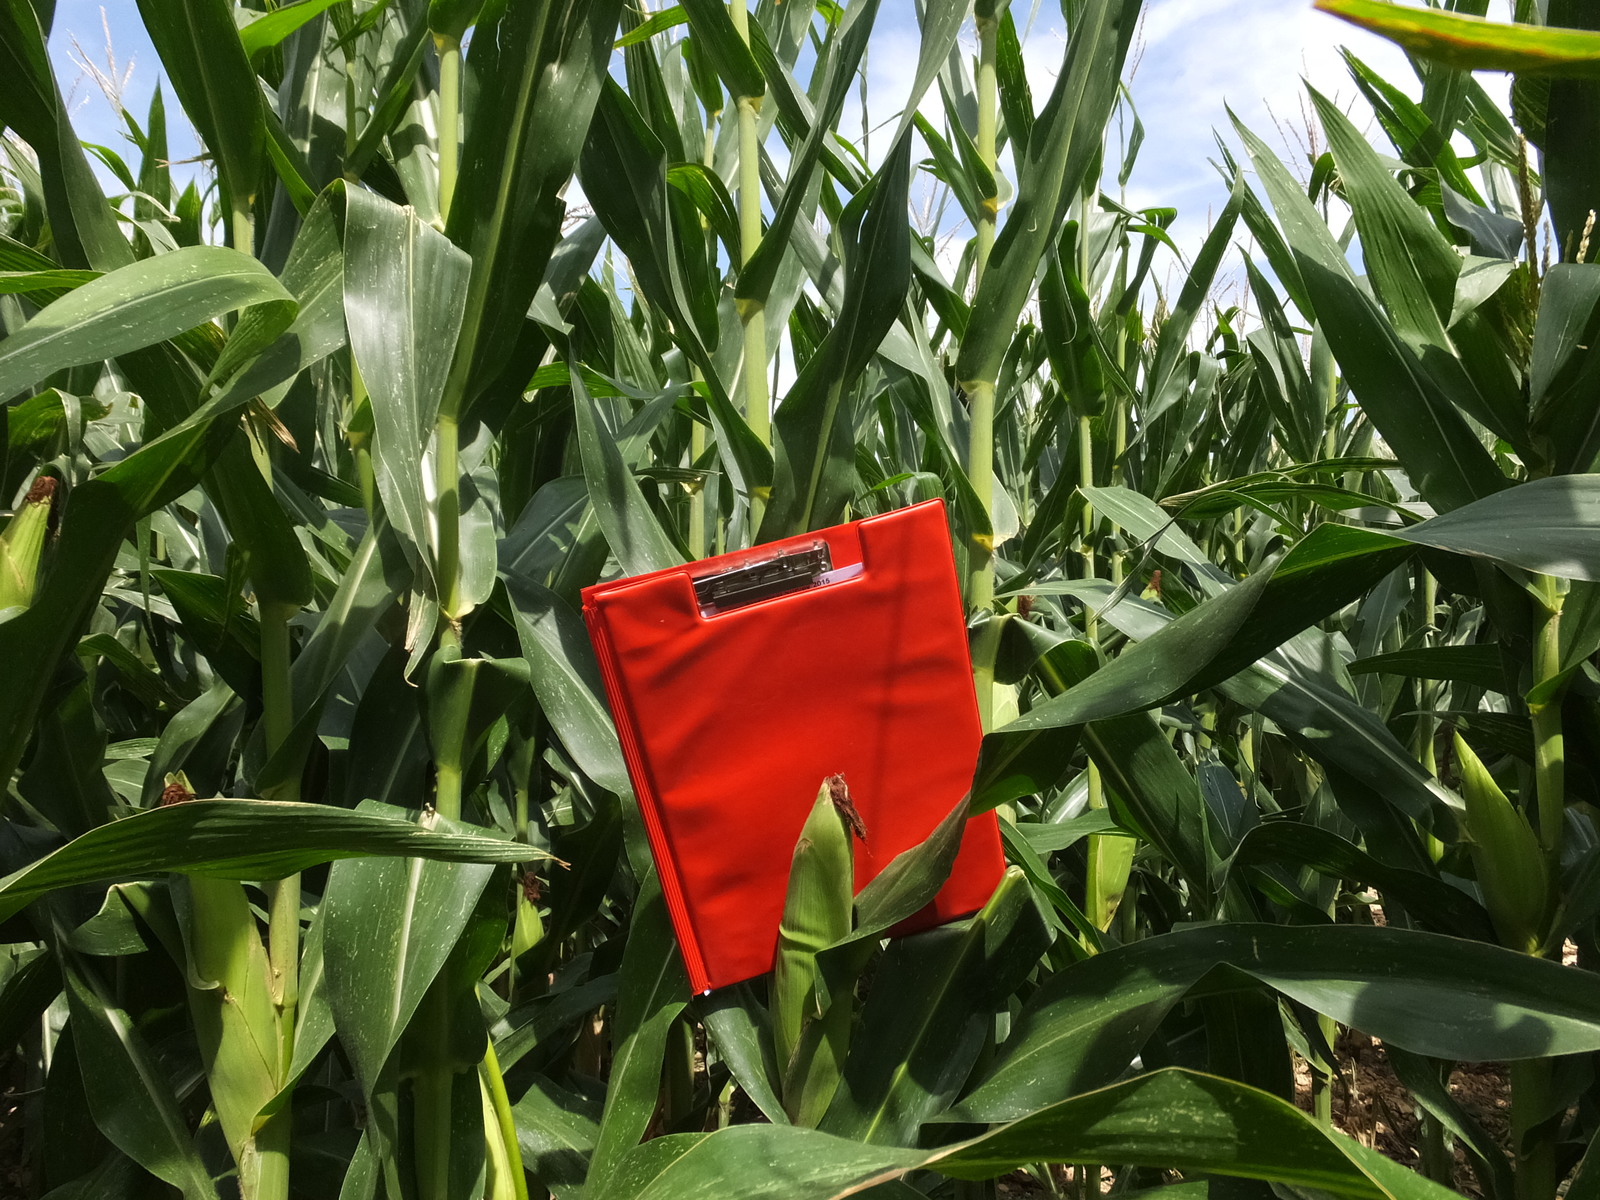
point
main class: Cropland
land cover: Maize
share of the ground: > 75 %
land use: Agriculture (excluding fallow land and kitchen gardens)
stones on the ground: < 10 %
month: August
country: ES
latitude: 41.5132
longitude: 0.1008
